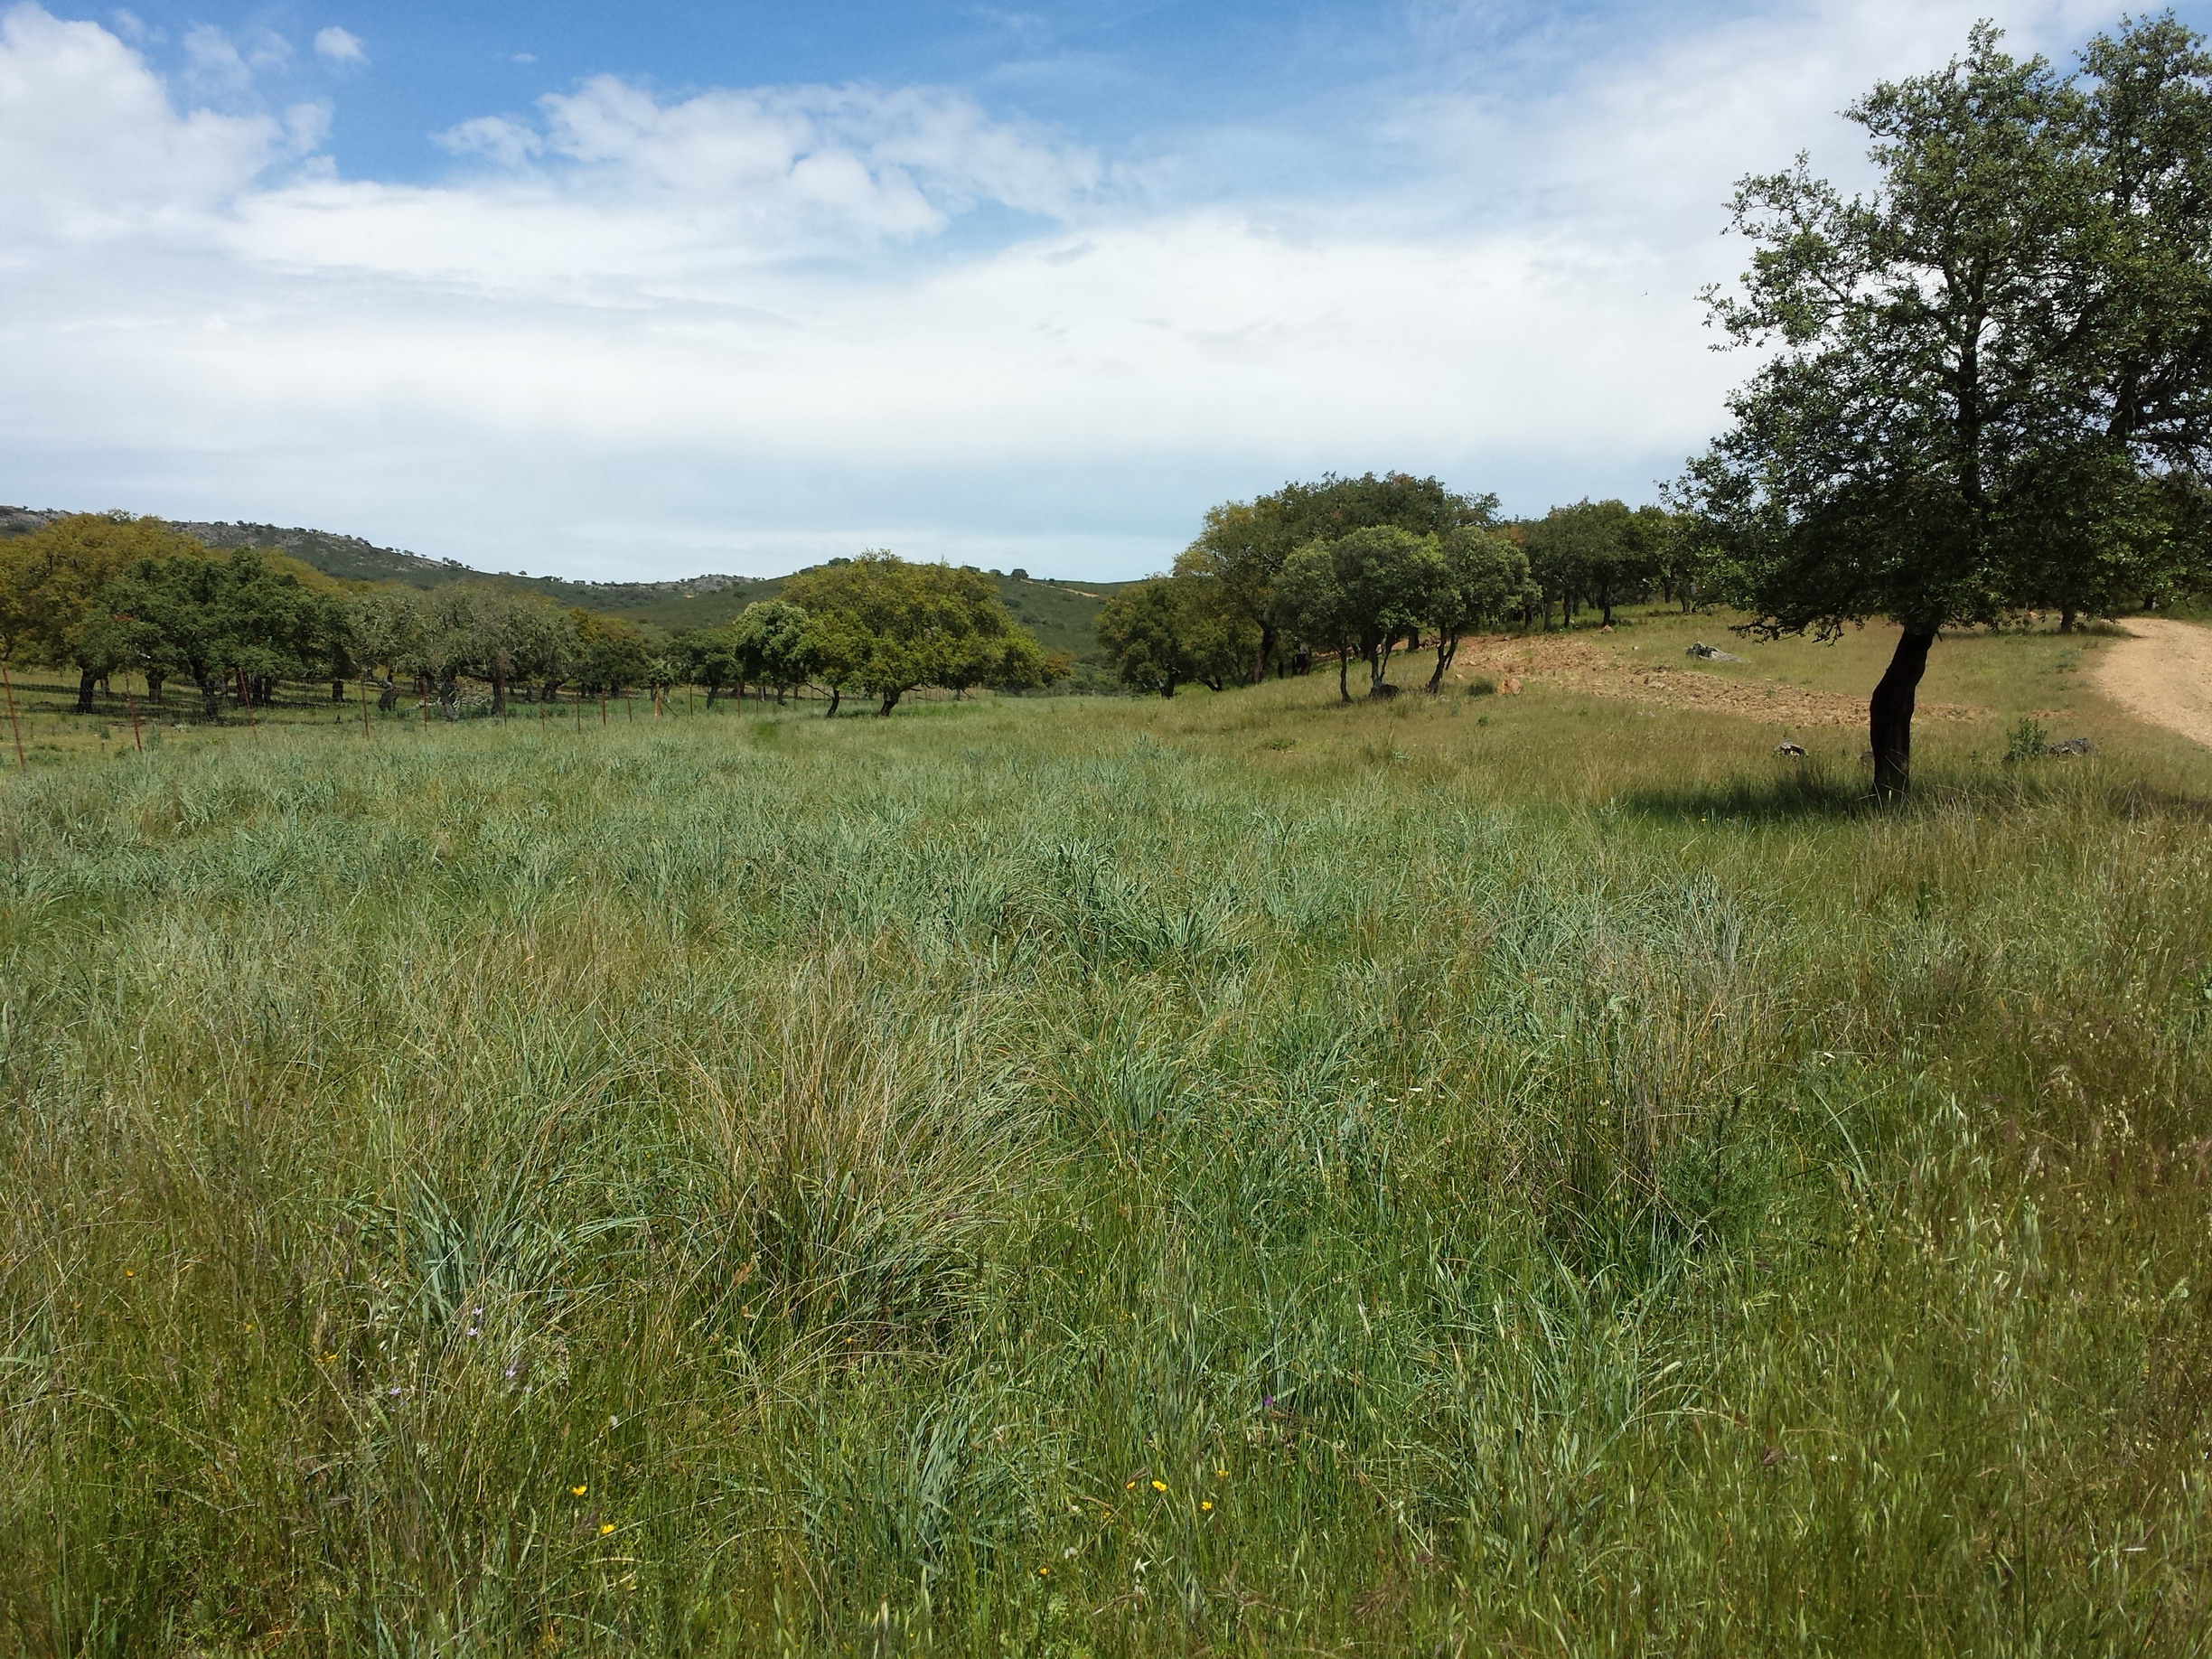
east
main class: Woodland
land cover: Broadleaved woodland
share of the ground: 25 - 50 %
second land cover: Grassland without tree/shrub cover
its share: > 75 %
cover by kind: herbaceous plants 75 %, broadleaved forest trees 25 %
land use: Forestry
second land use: Agriculture (excluding fallow land and kitchen gardens)
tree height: < 5 m
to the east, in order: Broadleaved woodland; Grassland without tree/shrub cover; Broadleaved woodland
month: May
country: ES
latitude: 39.5504
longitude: -7.1820
